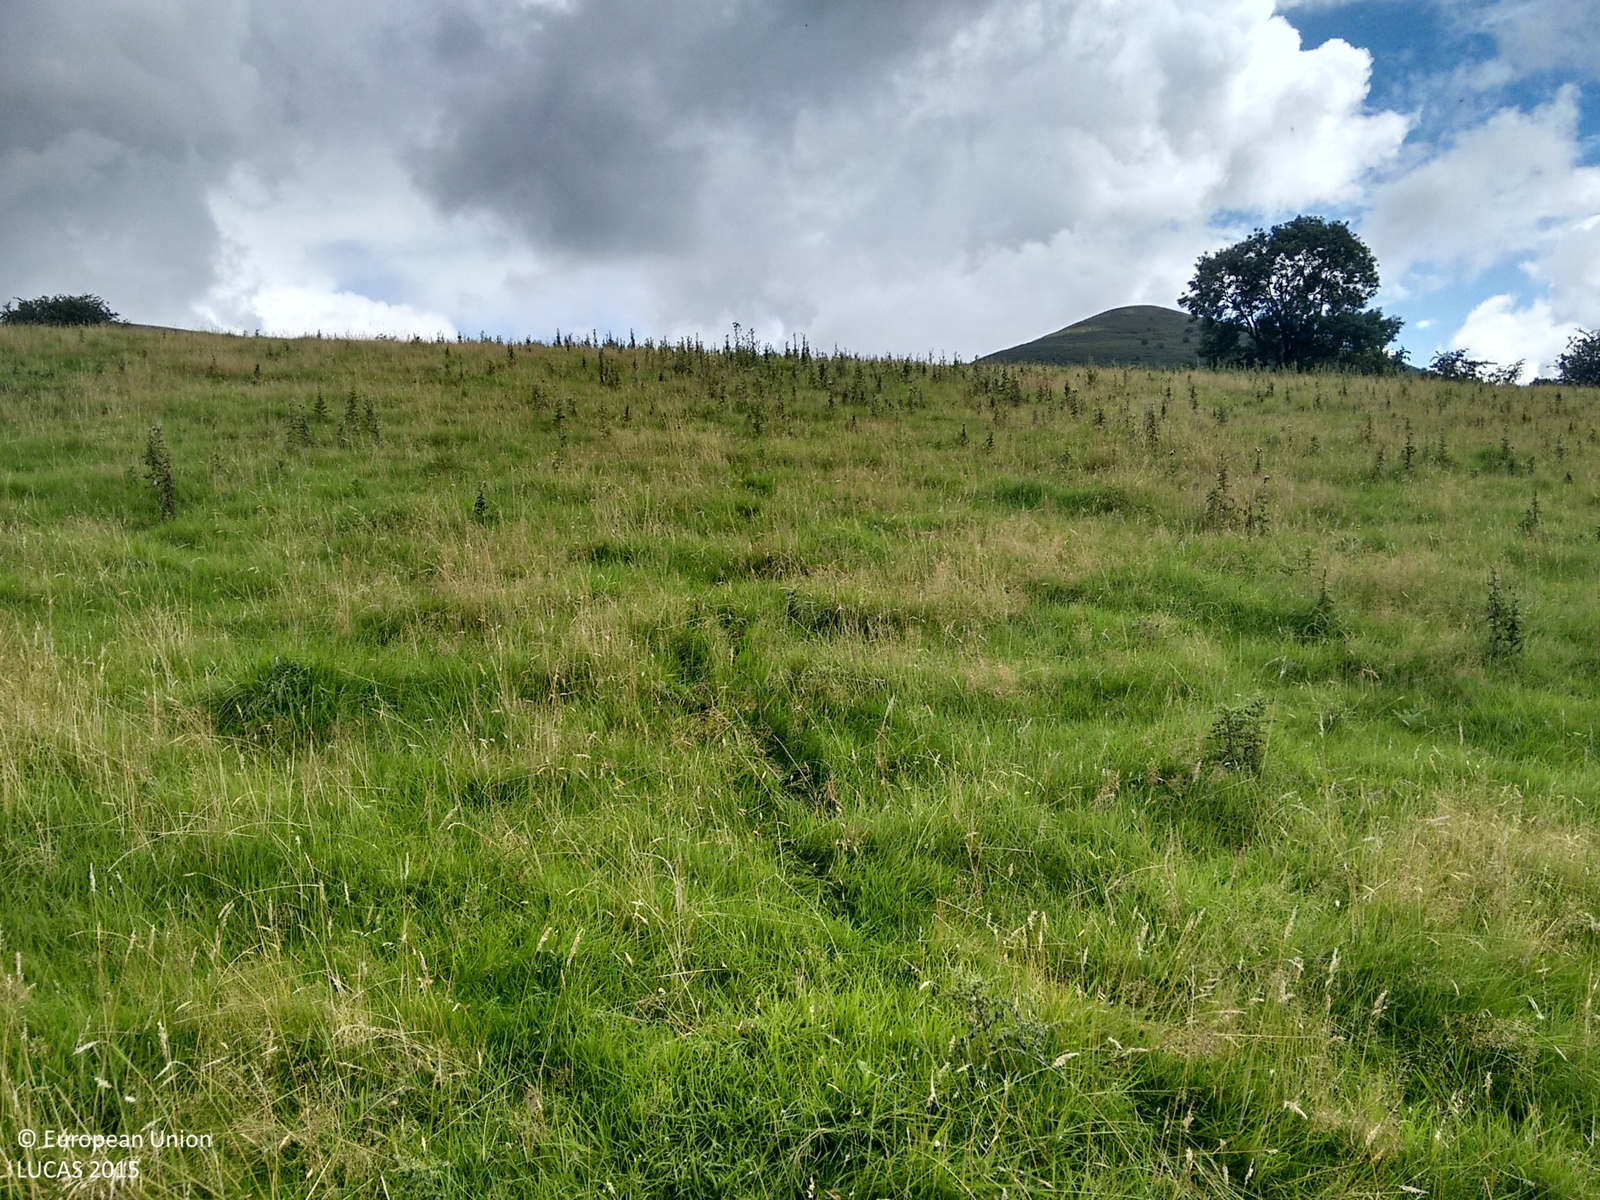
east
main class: Grassland
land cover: Grassland without tree/shrub cover
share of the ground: > 75 %
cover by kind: herbaceous plants 100 %
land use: Agriculture (excluding fallow land and kitchen gardens)
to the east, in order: Grassland without tree/shrub cover; Electric lines; Grassland without tree/shrub cover; Lines of trees; Tracks; Lines of trees; Fences; Grassland without tree/shrub cover
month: September
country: GB
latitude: 51.9475
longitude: -3.1870
